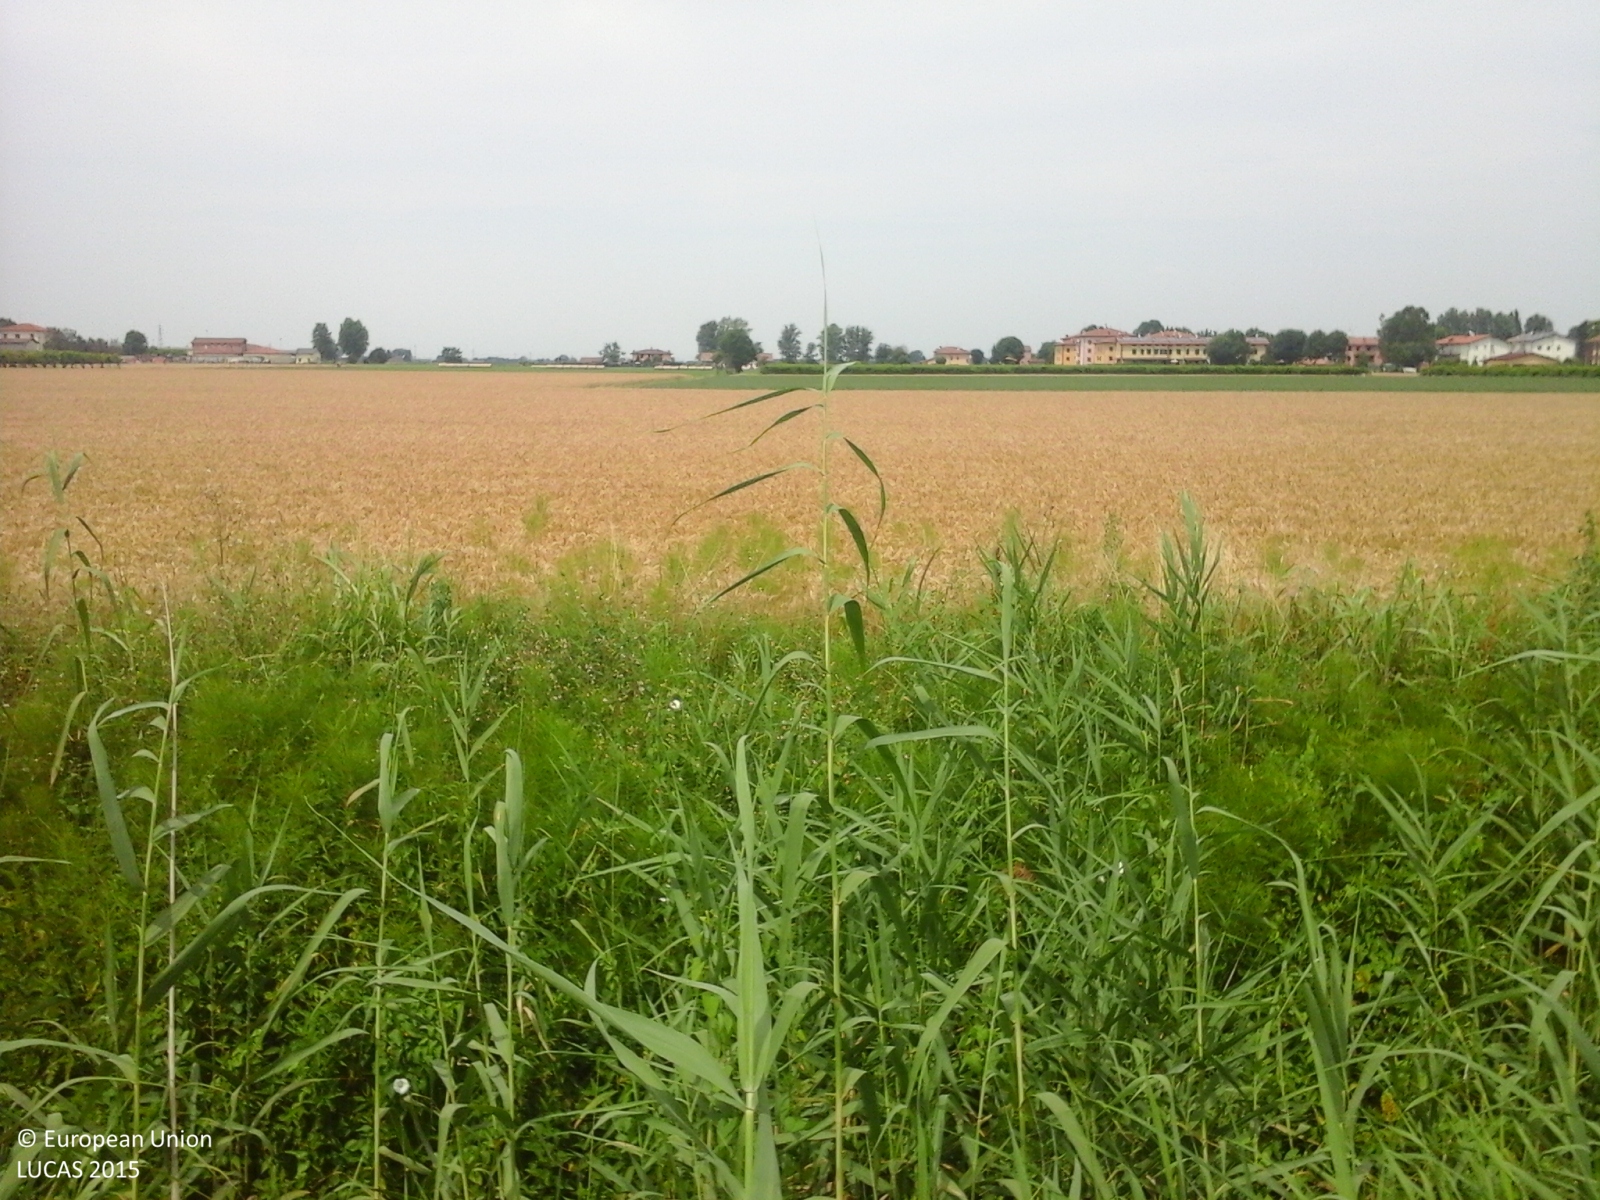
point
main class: Cropland
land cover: Common wheat
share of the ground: > 75 %
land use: Agriculture (excluding fallow land and kitchen gardens)
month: June
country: IT
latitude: 44.6336
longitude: 11.0692
